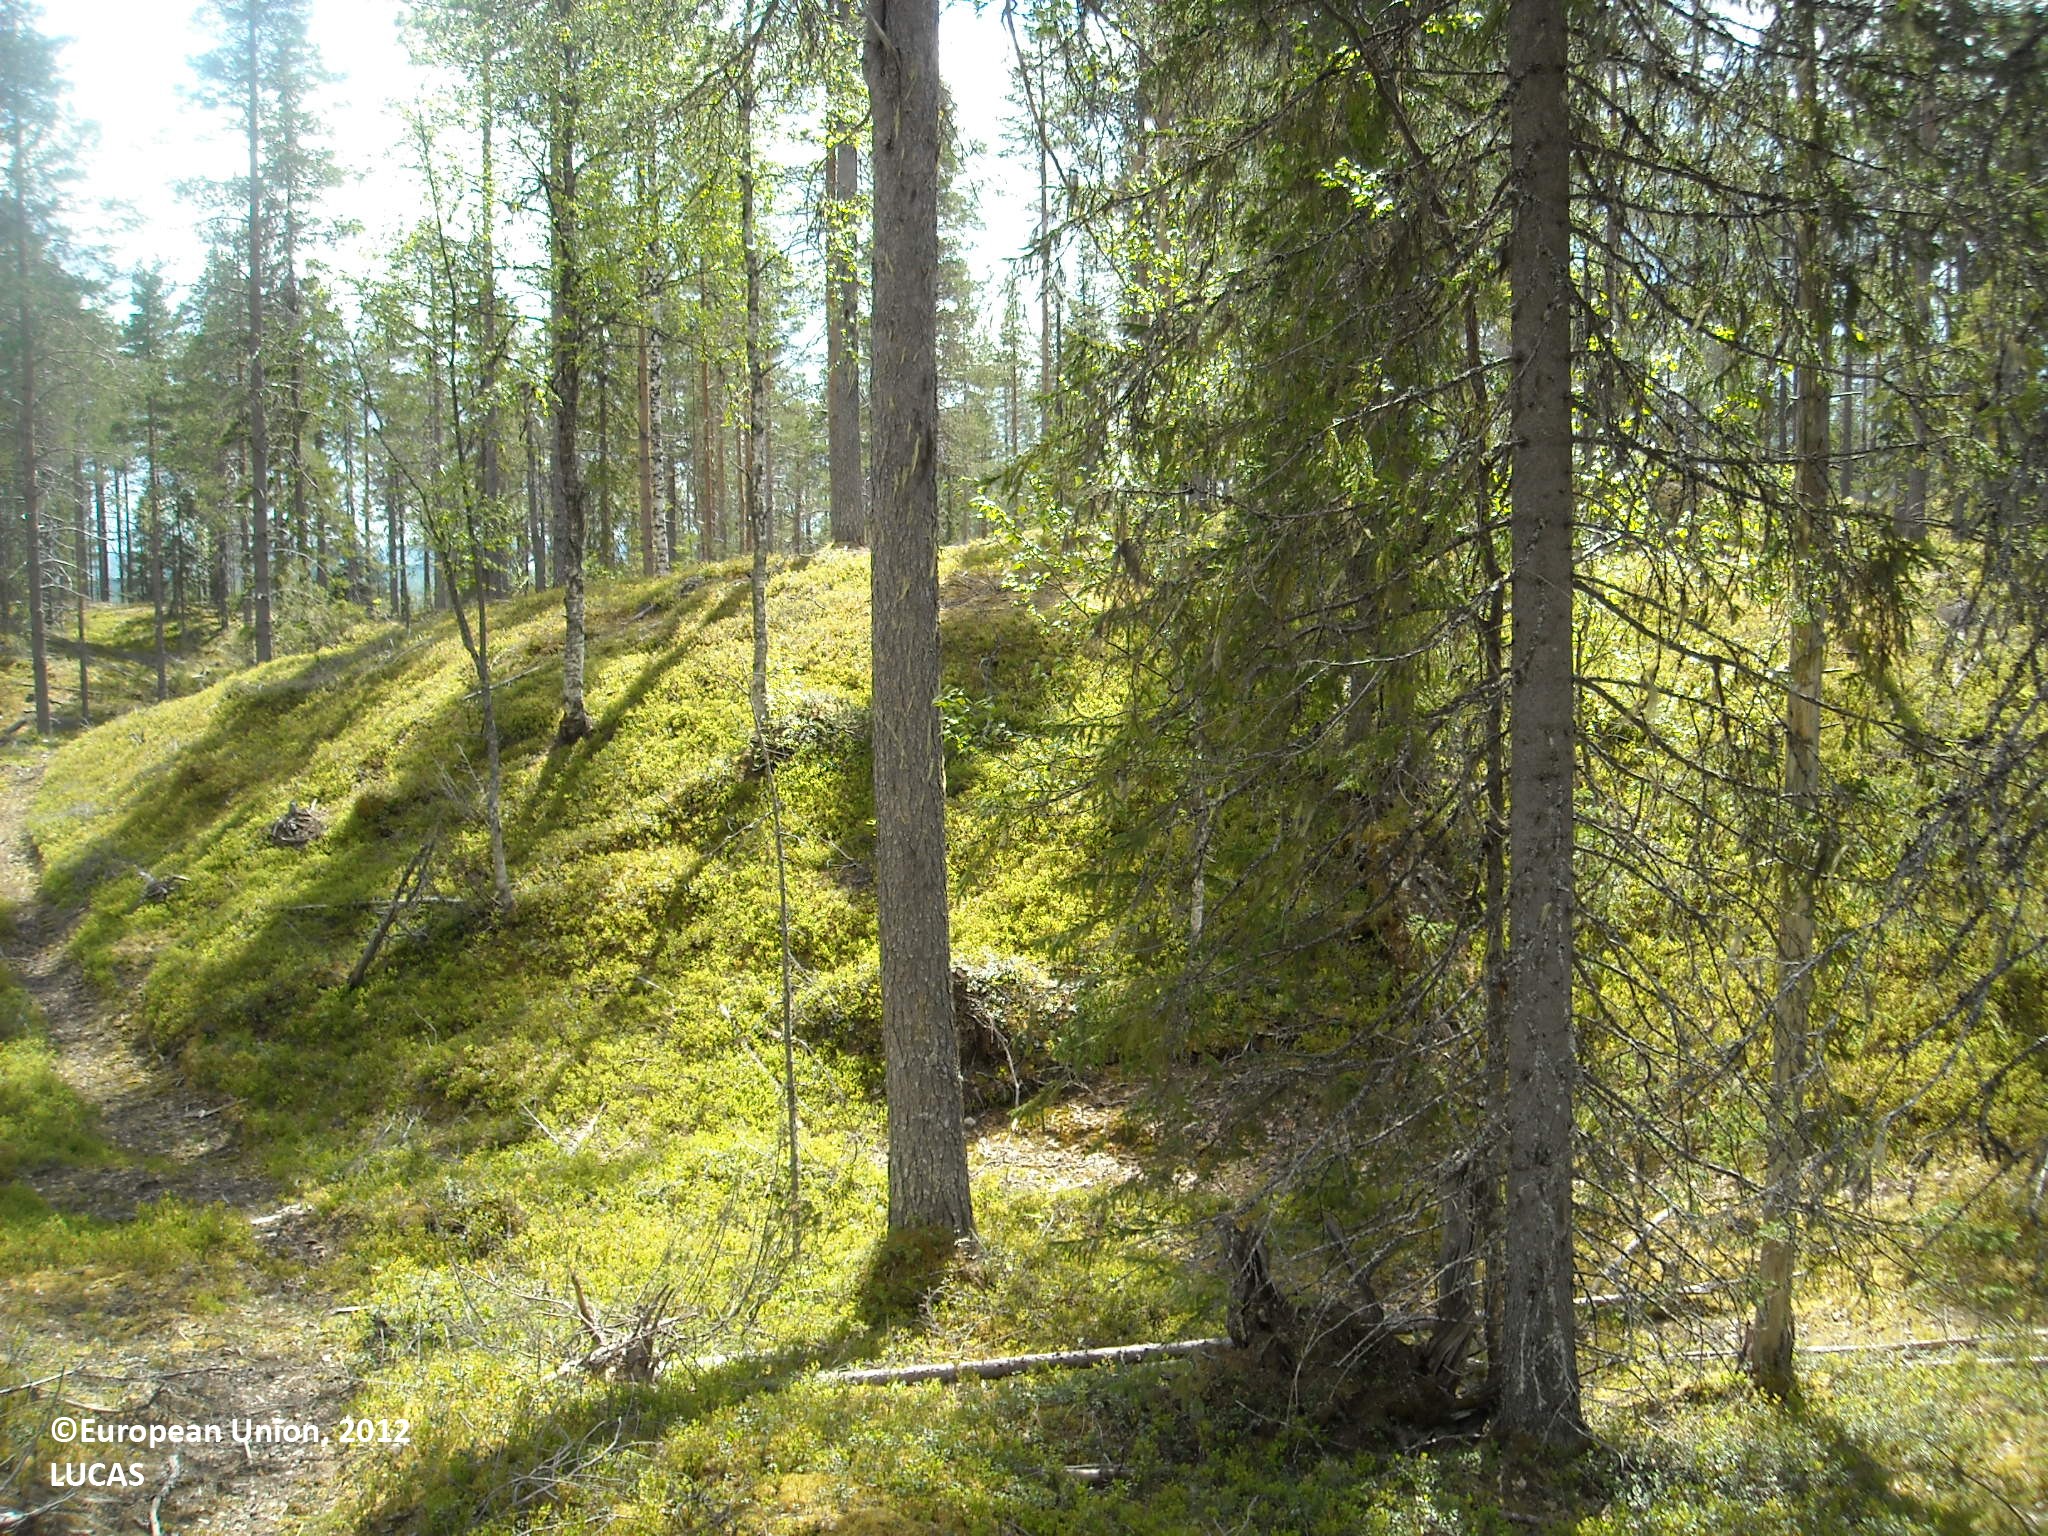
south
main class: Woodland
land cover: Pine dominated coniferous woodland
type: boreal forest
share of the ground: 50 - 75 %
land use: Forestry
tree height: > 5 m
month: June
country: FI
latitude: 65.3513
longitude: 27.8271
